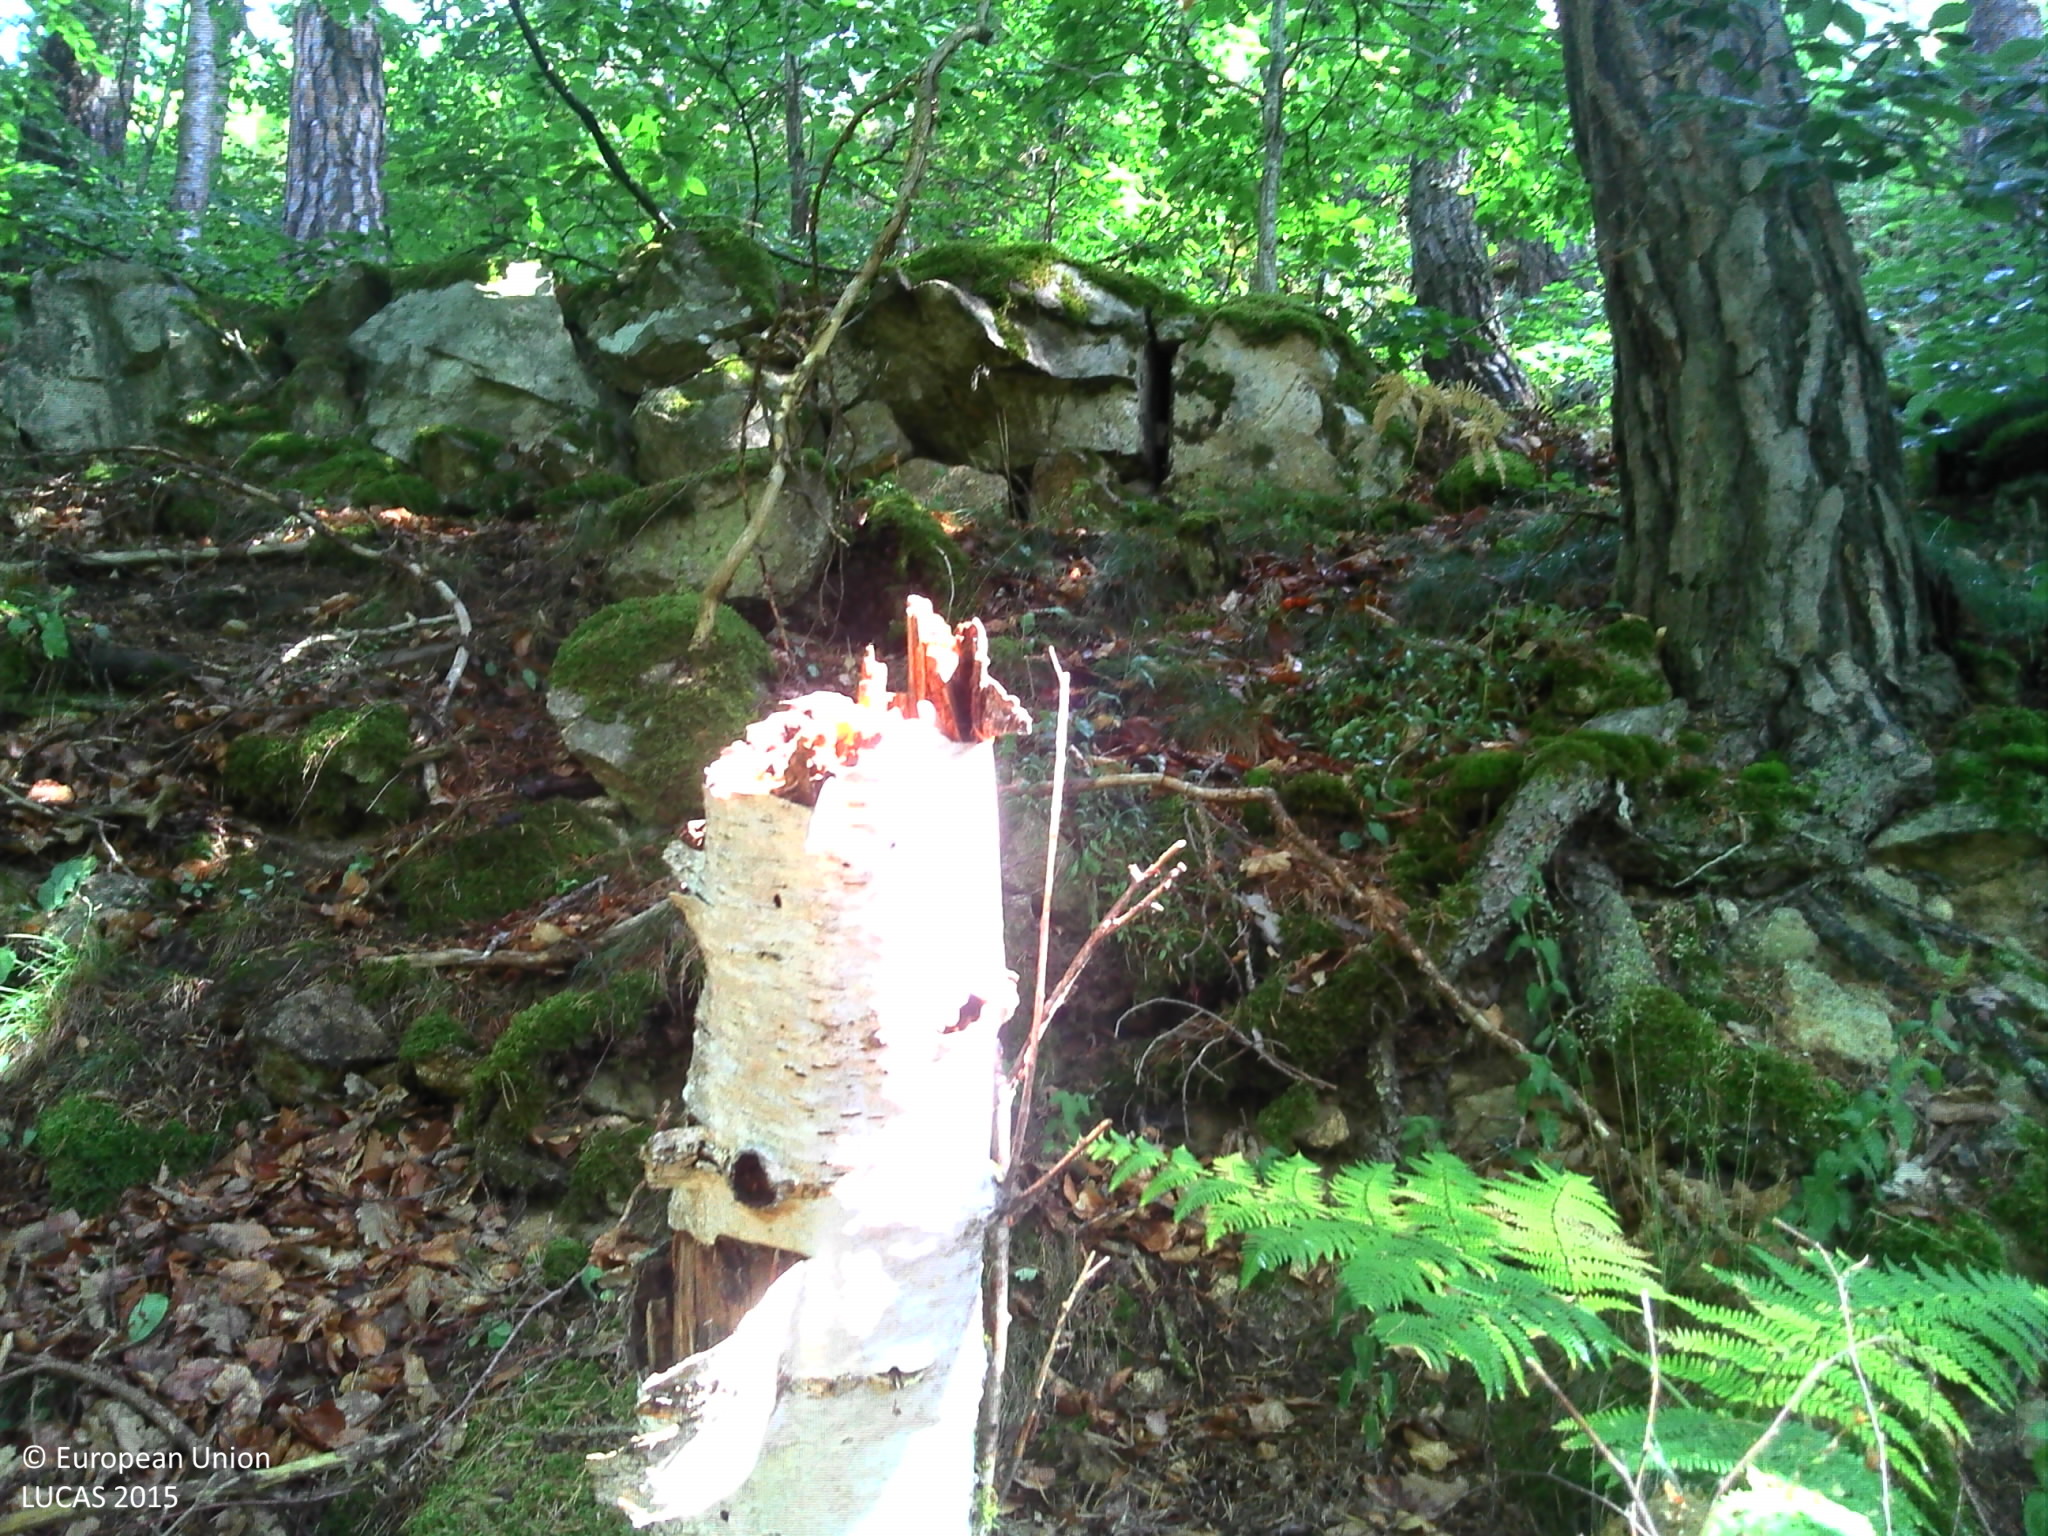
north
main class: Woodland
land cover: Pine dominated mixed woodland
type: mesophytic deciduous forest
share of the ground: > 75 %
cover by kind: broadleaved forest trees 65 %, coniferous forest trees 25 %, herbaceous plants 10 %
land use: Forestry
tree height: > 5 m
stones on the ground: < 10 %
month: July
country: FR
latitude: 45.1624
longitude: 4.1649
